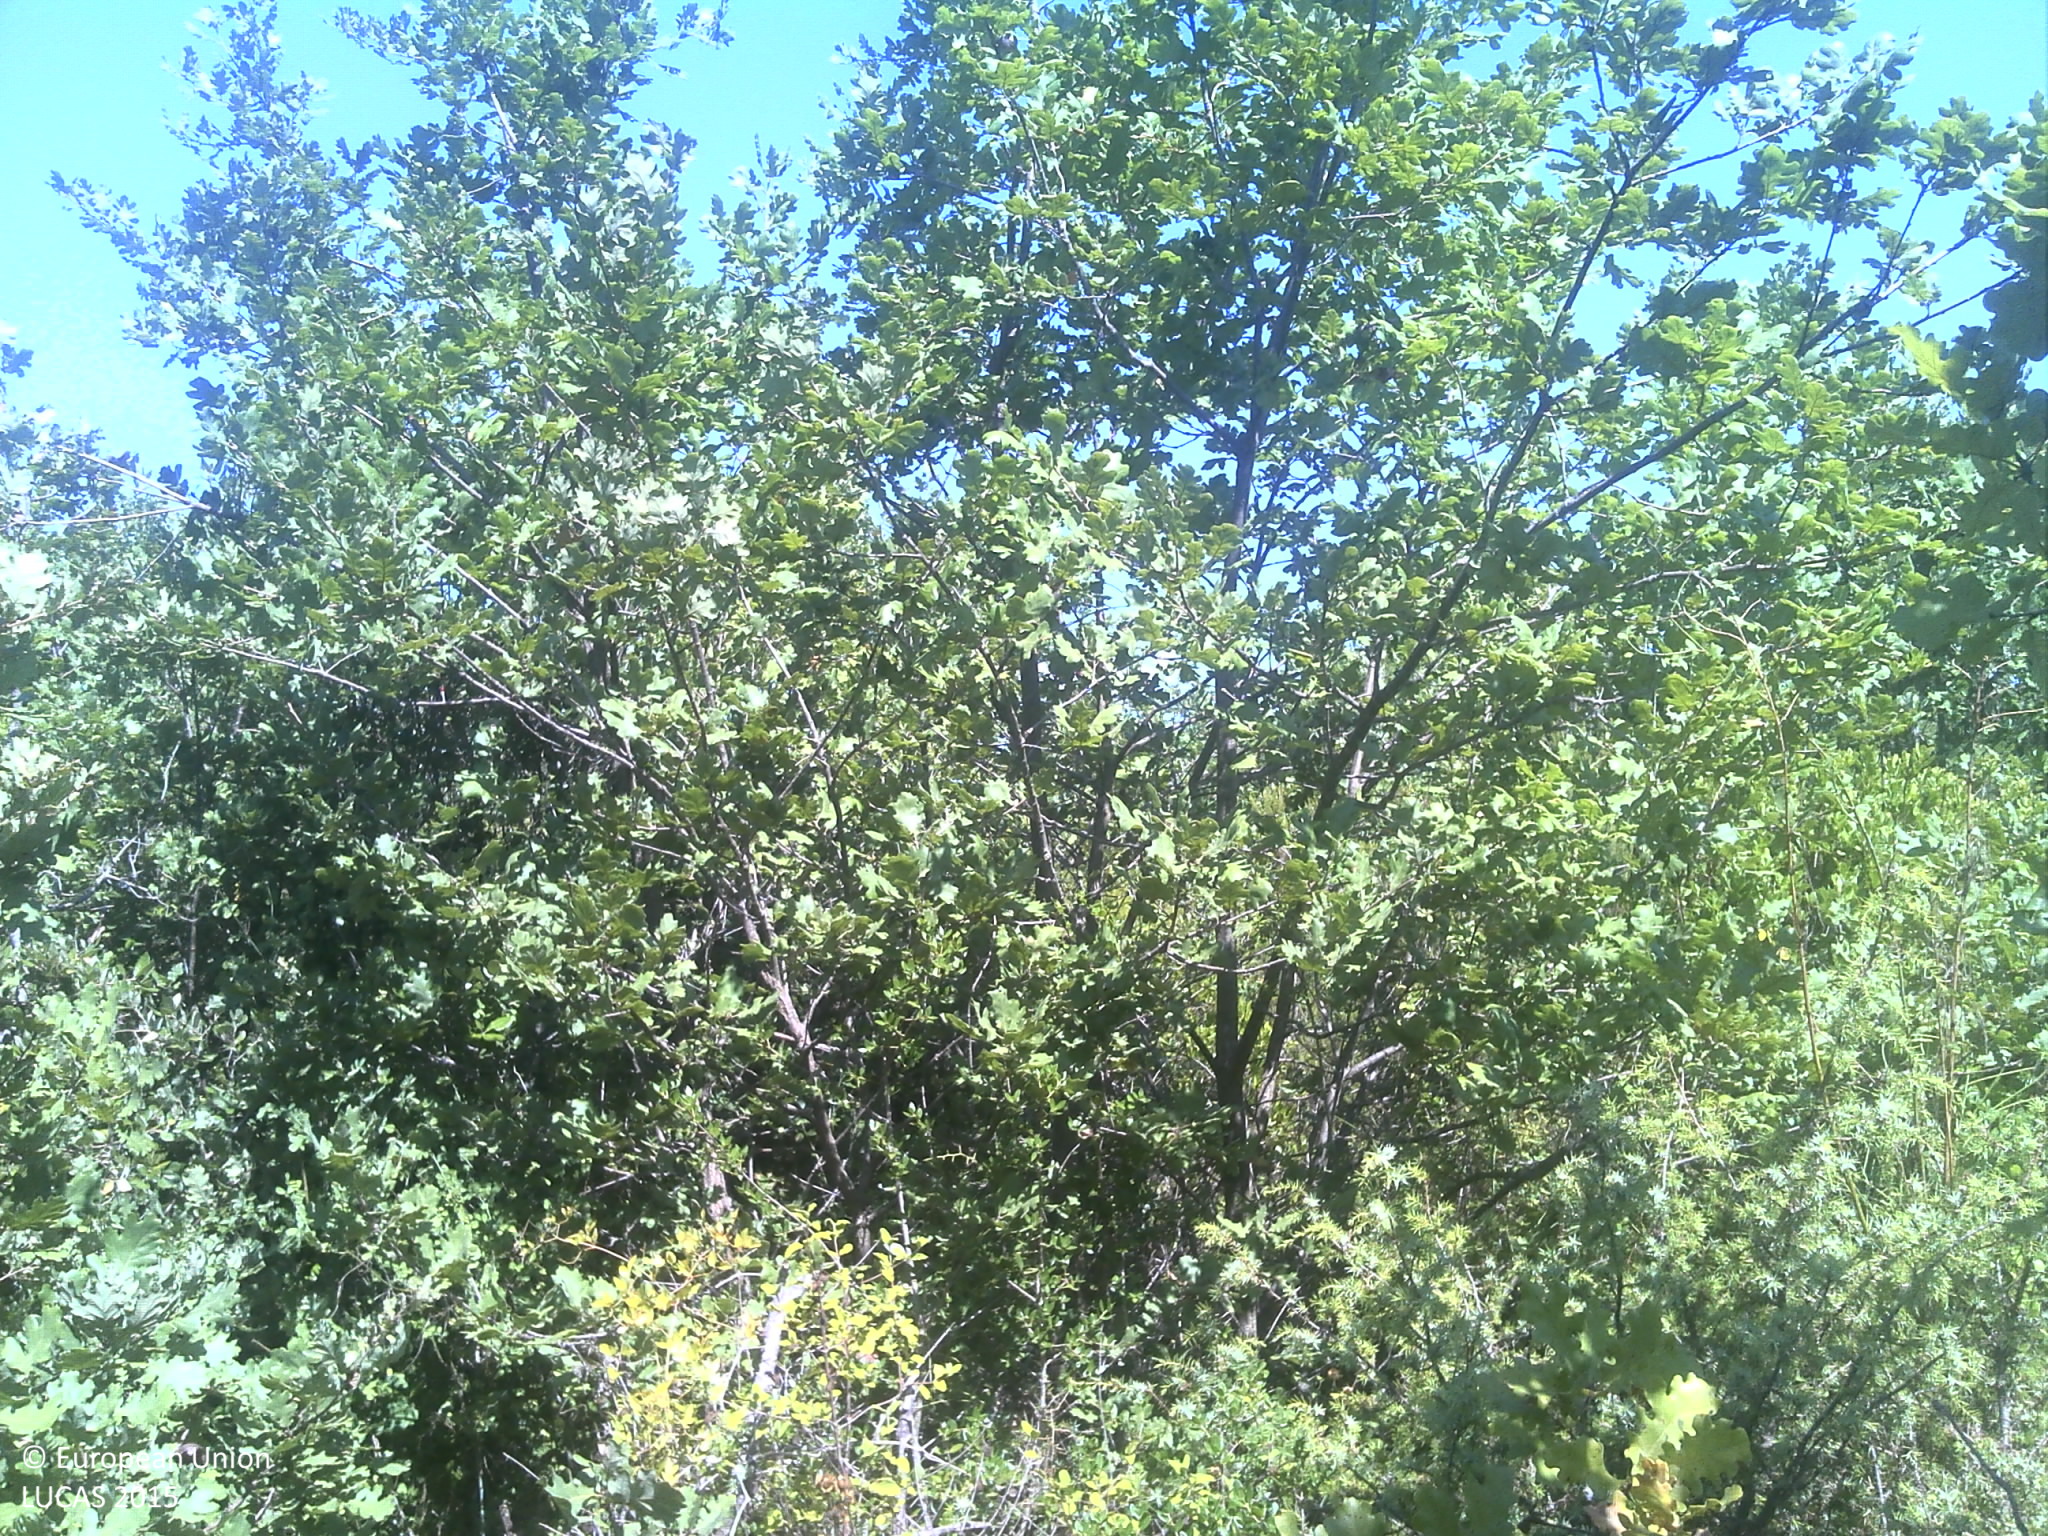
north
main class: Woodland
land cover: Broadleaved woodland
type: thermophilous deciduous forest
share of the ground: > 75 %
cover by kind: shrubs 65 %, broadleaved forest trees 20 %, unconsolidated bare surface 10 %, coniferous forest trees 5 %
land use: Semi-natural and natural areas not in use
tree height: > 5 m
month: August
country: HR
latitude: 43.9164
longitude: 15.4834
